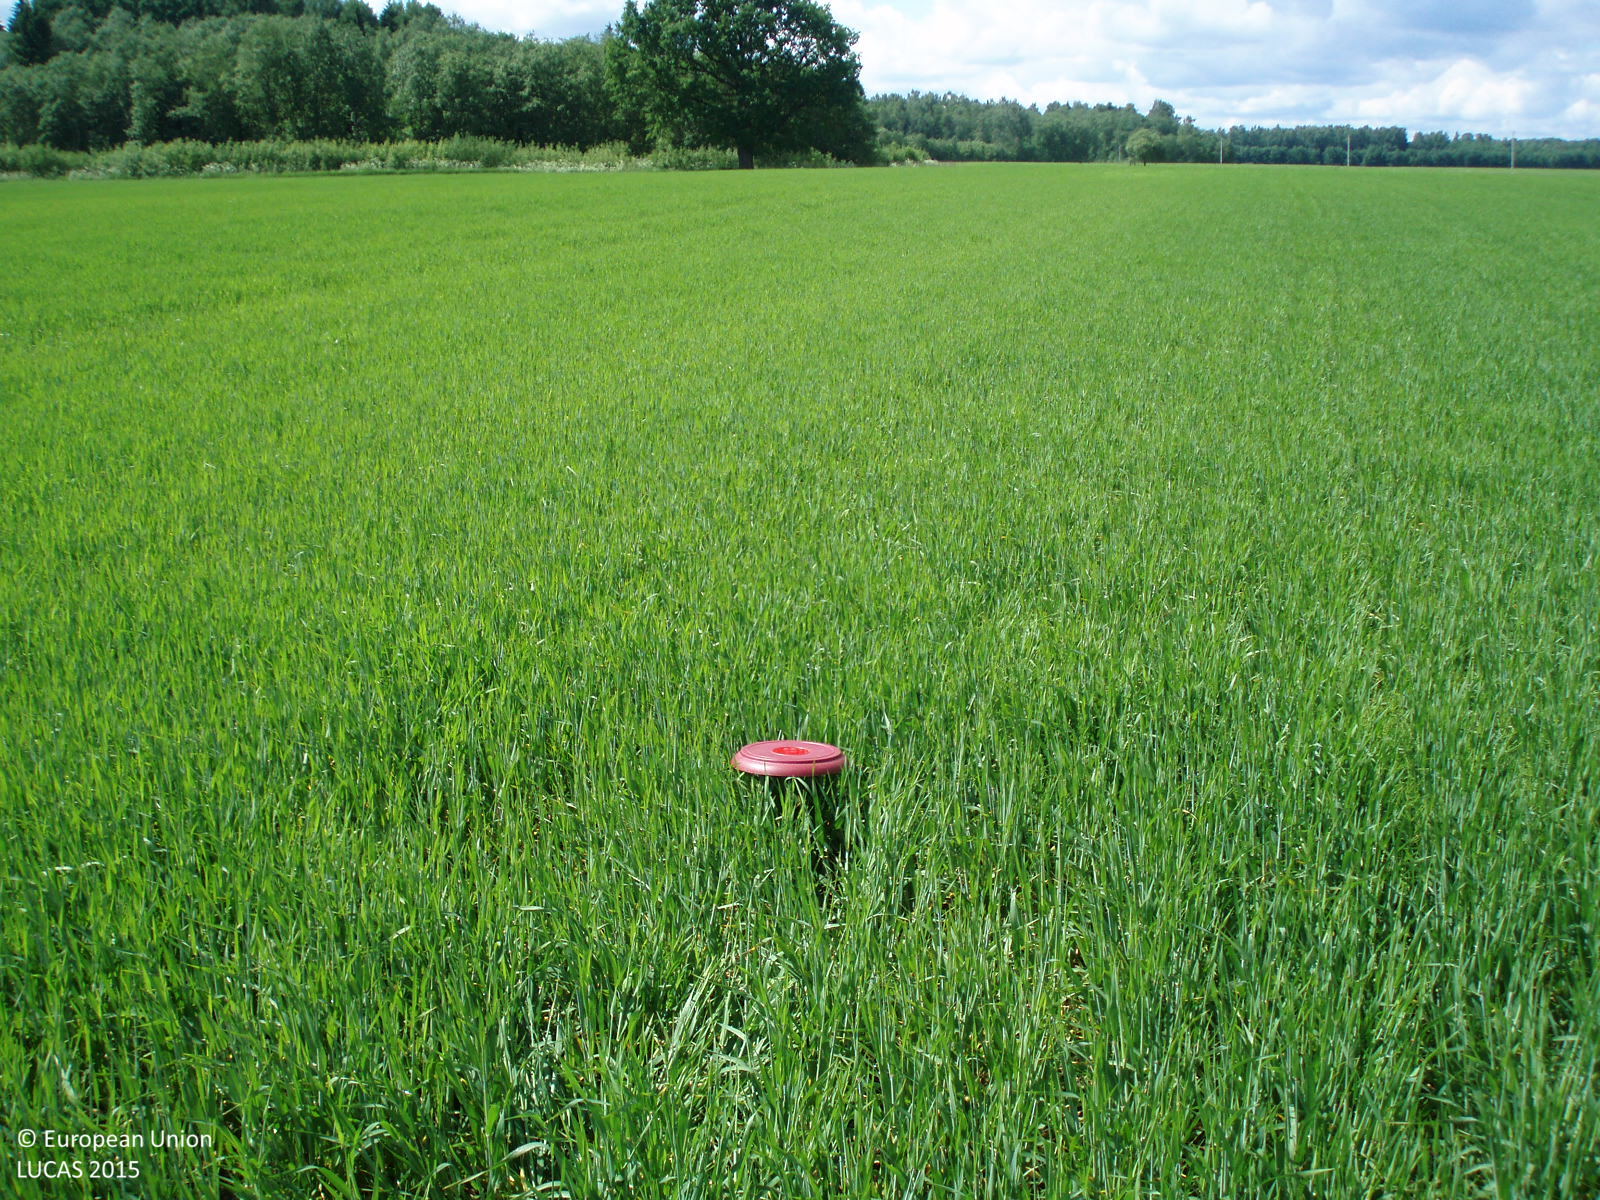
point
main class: Cropland
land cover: Barley
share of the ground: > 75 %
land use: Agriculture (excluding fallow land and kitchen gardens)
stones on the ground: < 10 %
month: June
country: LT
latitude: 56.2619
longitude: 23.2614
